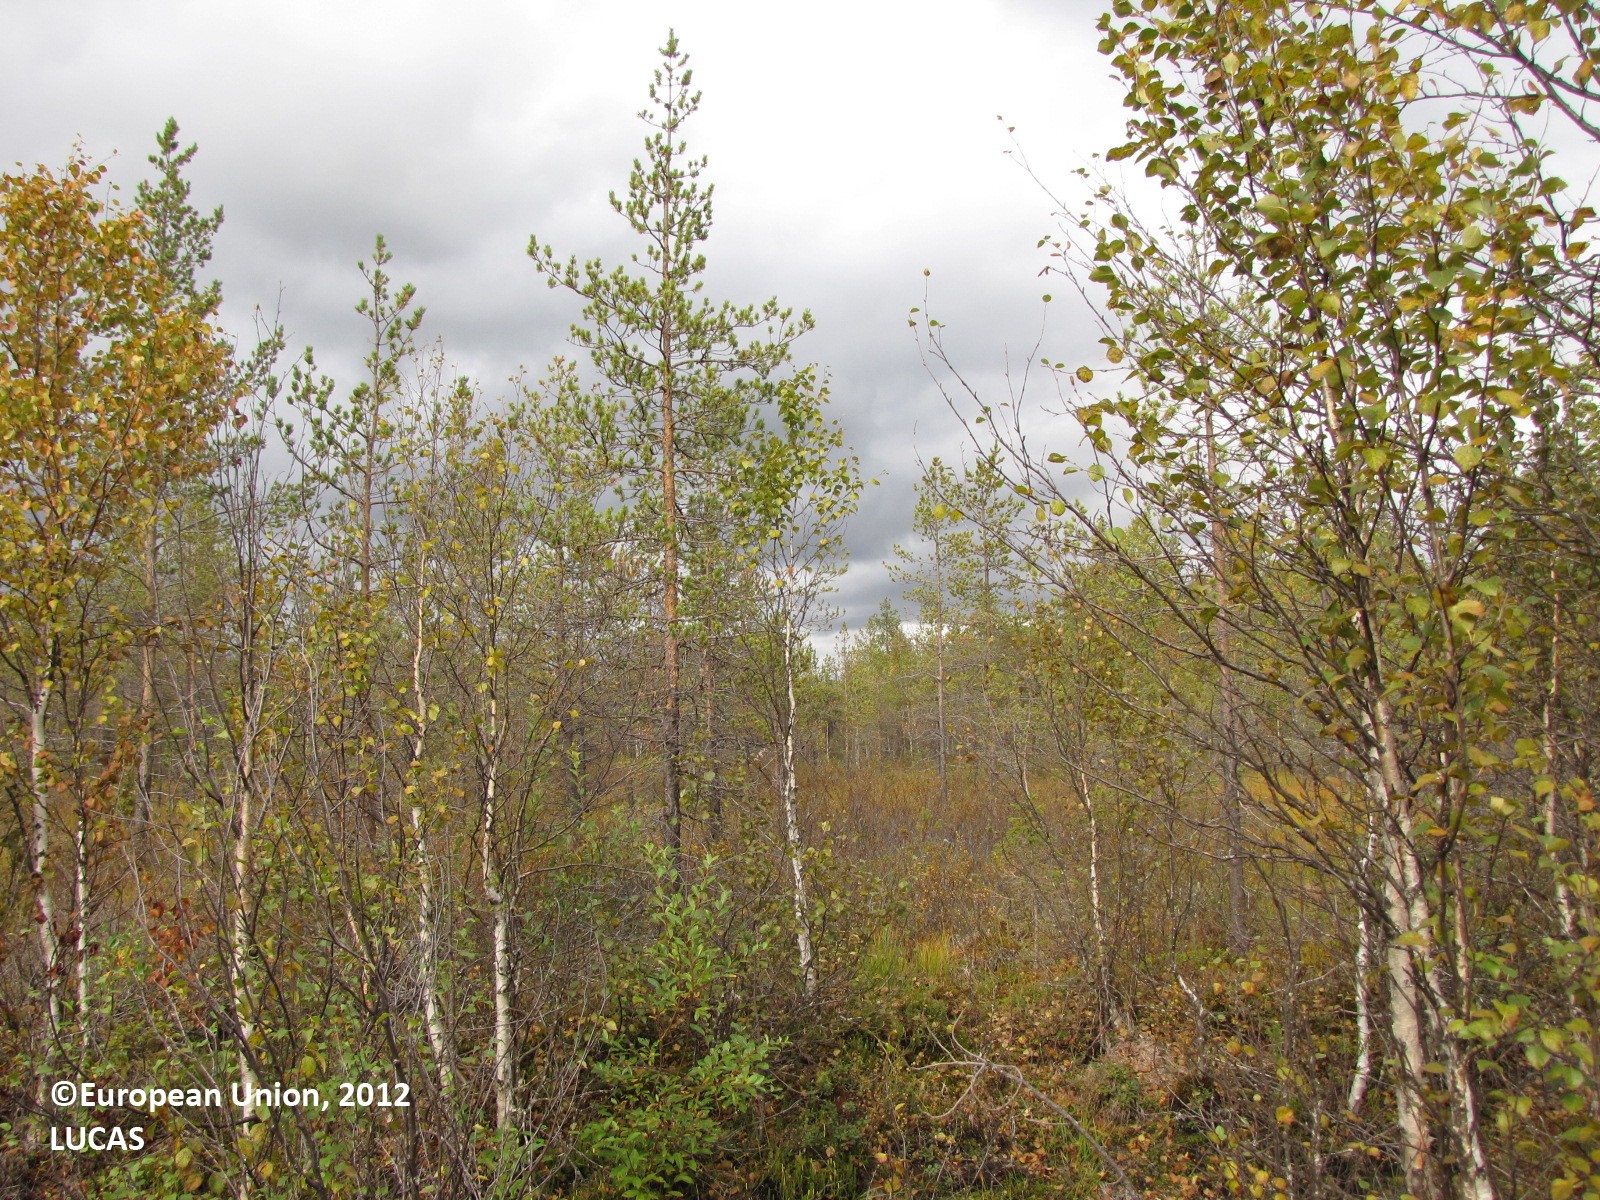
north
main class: Woodland
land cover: Pine dominated mixed woodland
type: boreal forest
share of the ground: 25 - 50 %
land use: Forestry
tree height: > 5 m
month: September
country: FI
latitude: 67.2227
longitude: 23.9838
